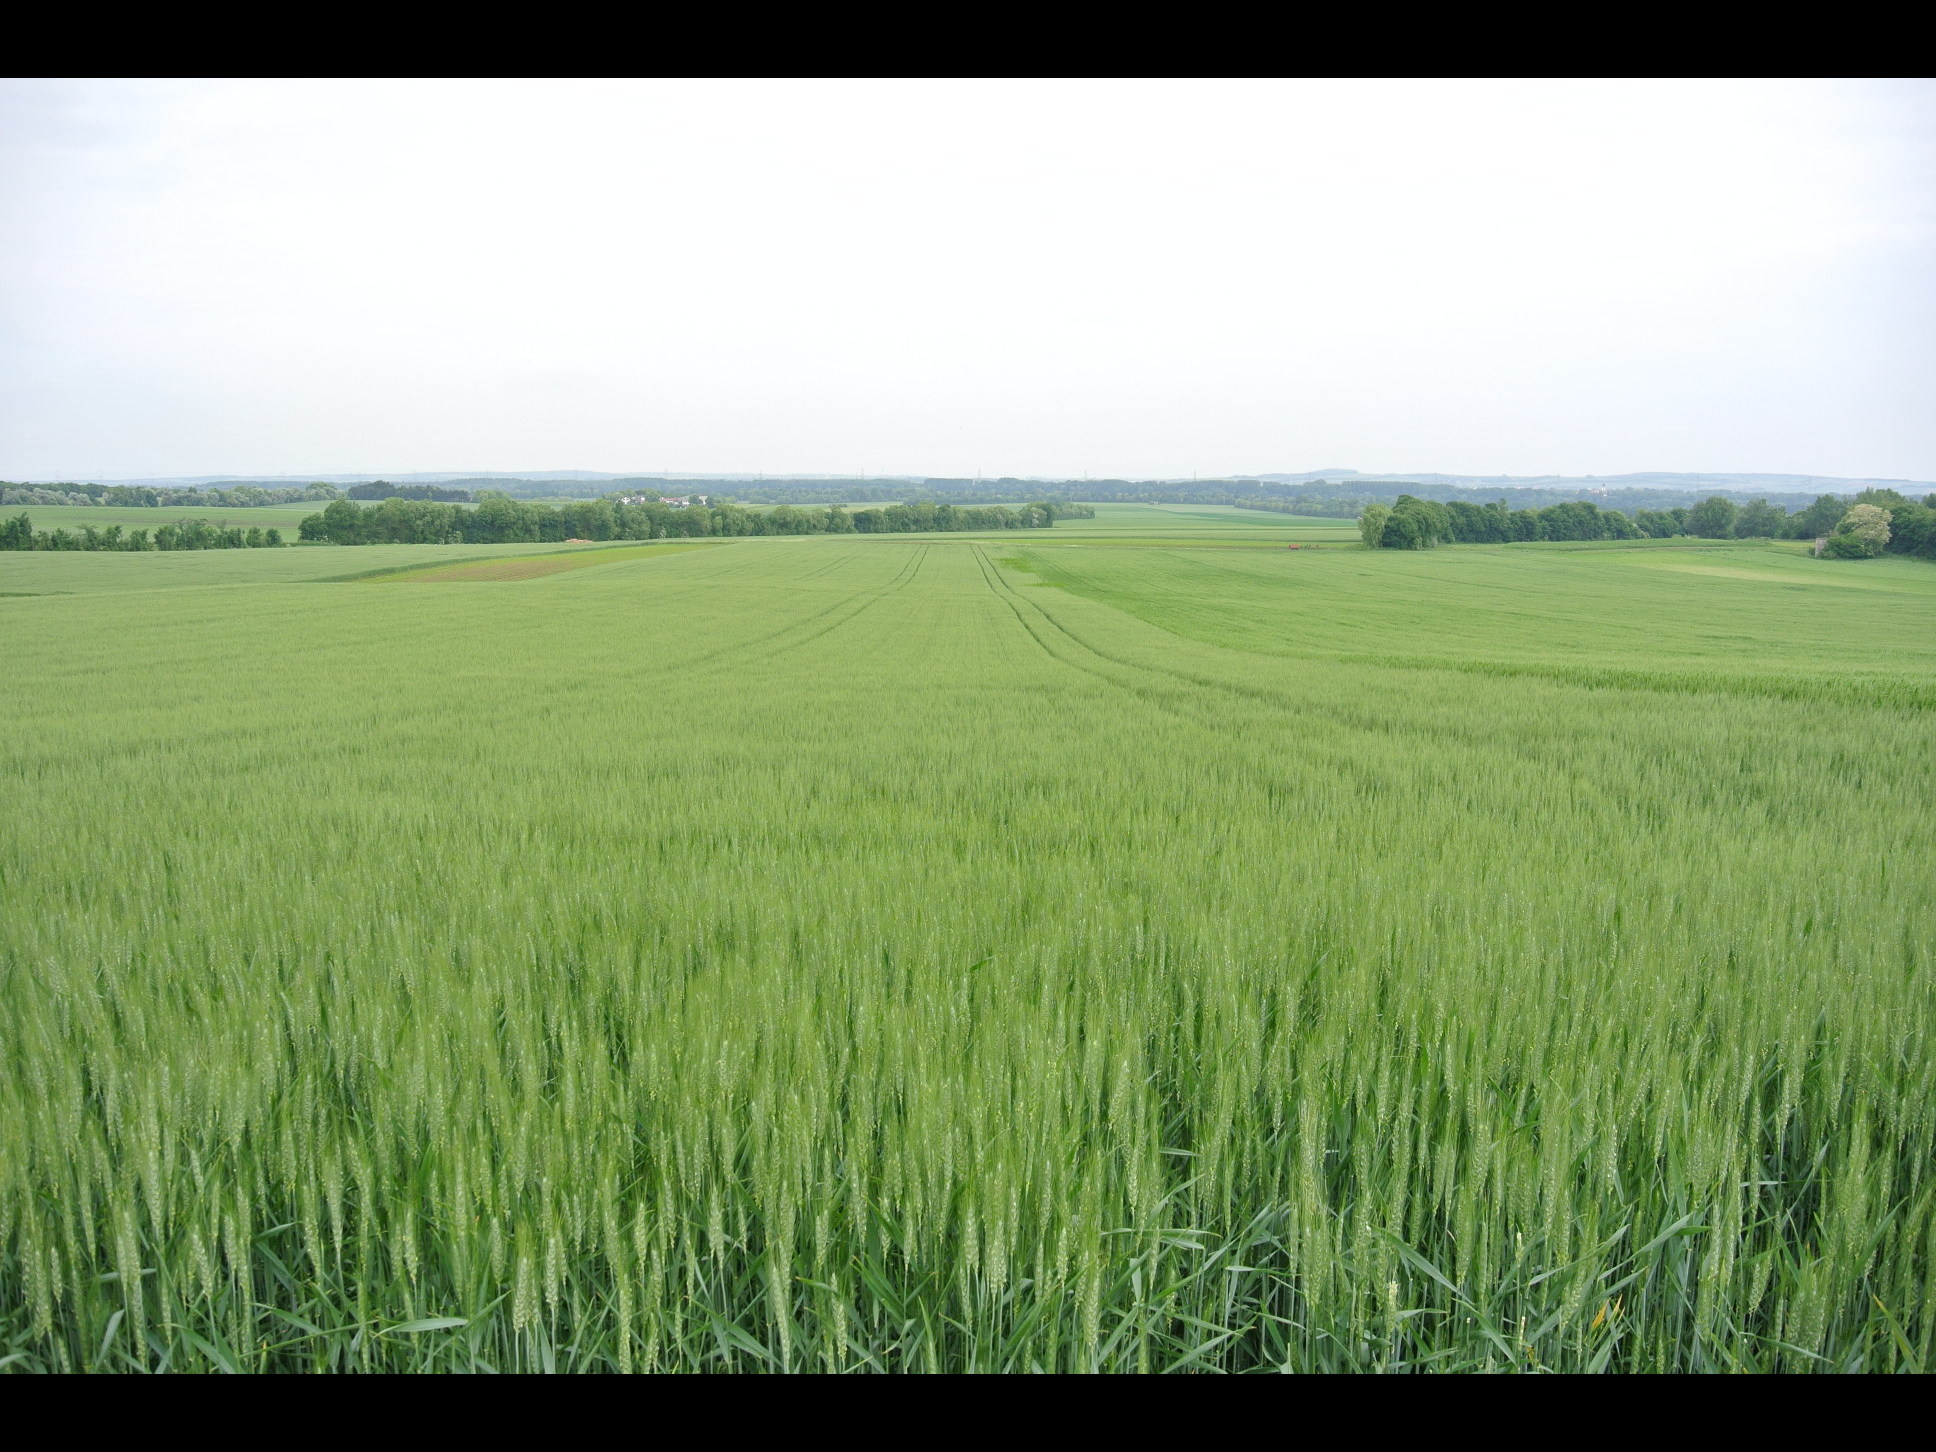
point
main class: Cropland
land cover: Durum wheat
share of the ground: > 75 %
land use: Agriculture (excluding fallow land and kitchen gardens)
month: May
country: AT
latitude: 47.9873
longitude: 16.6382
